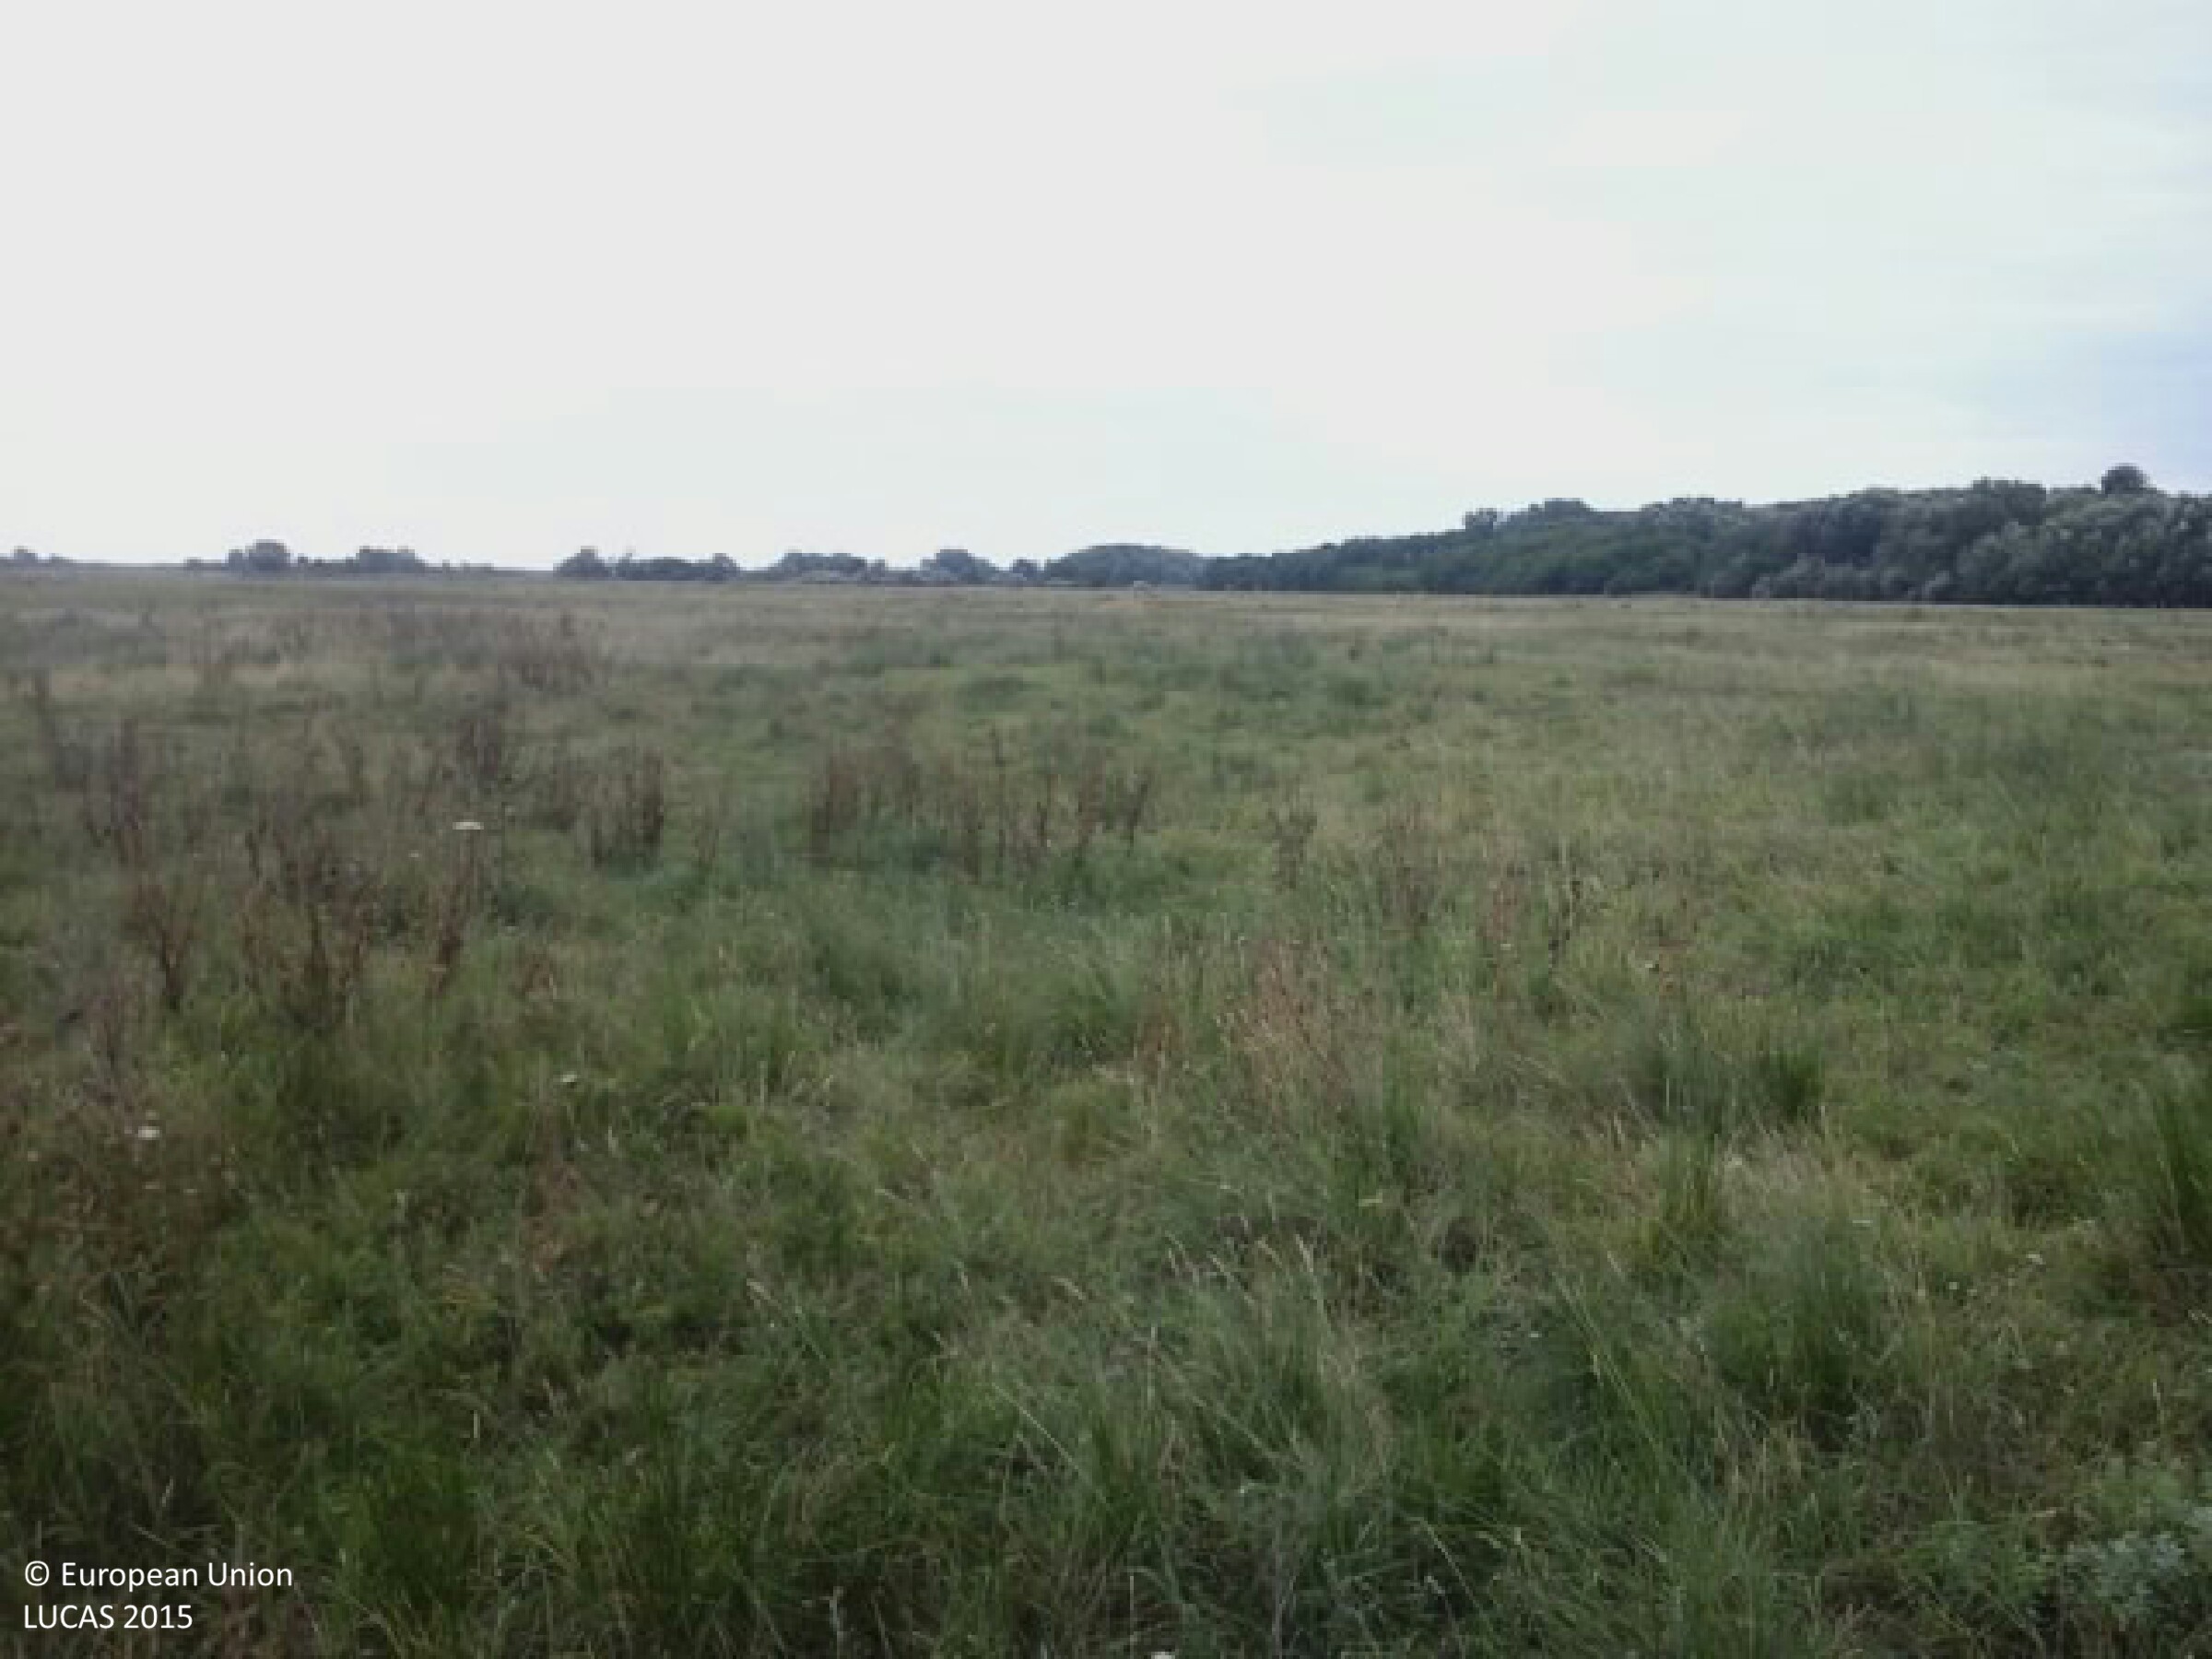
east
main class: Grassland
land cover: Grassland without tree/shrub cover
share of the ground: > 75 %
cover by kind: herbaceous plants 100 %
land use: Agriculture (excluding fallow land and kitchen gardens)
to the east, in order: Grassland without tree/shrub cover
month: June
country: HU
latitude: 46.6798
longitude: 19.6018
